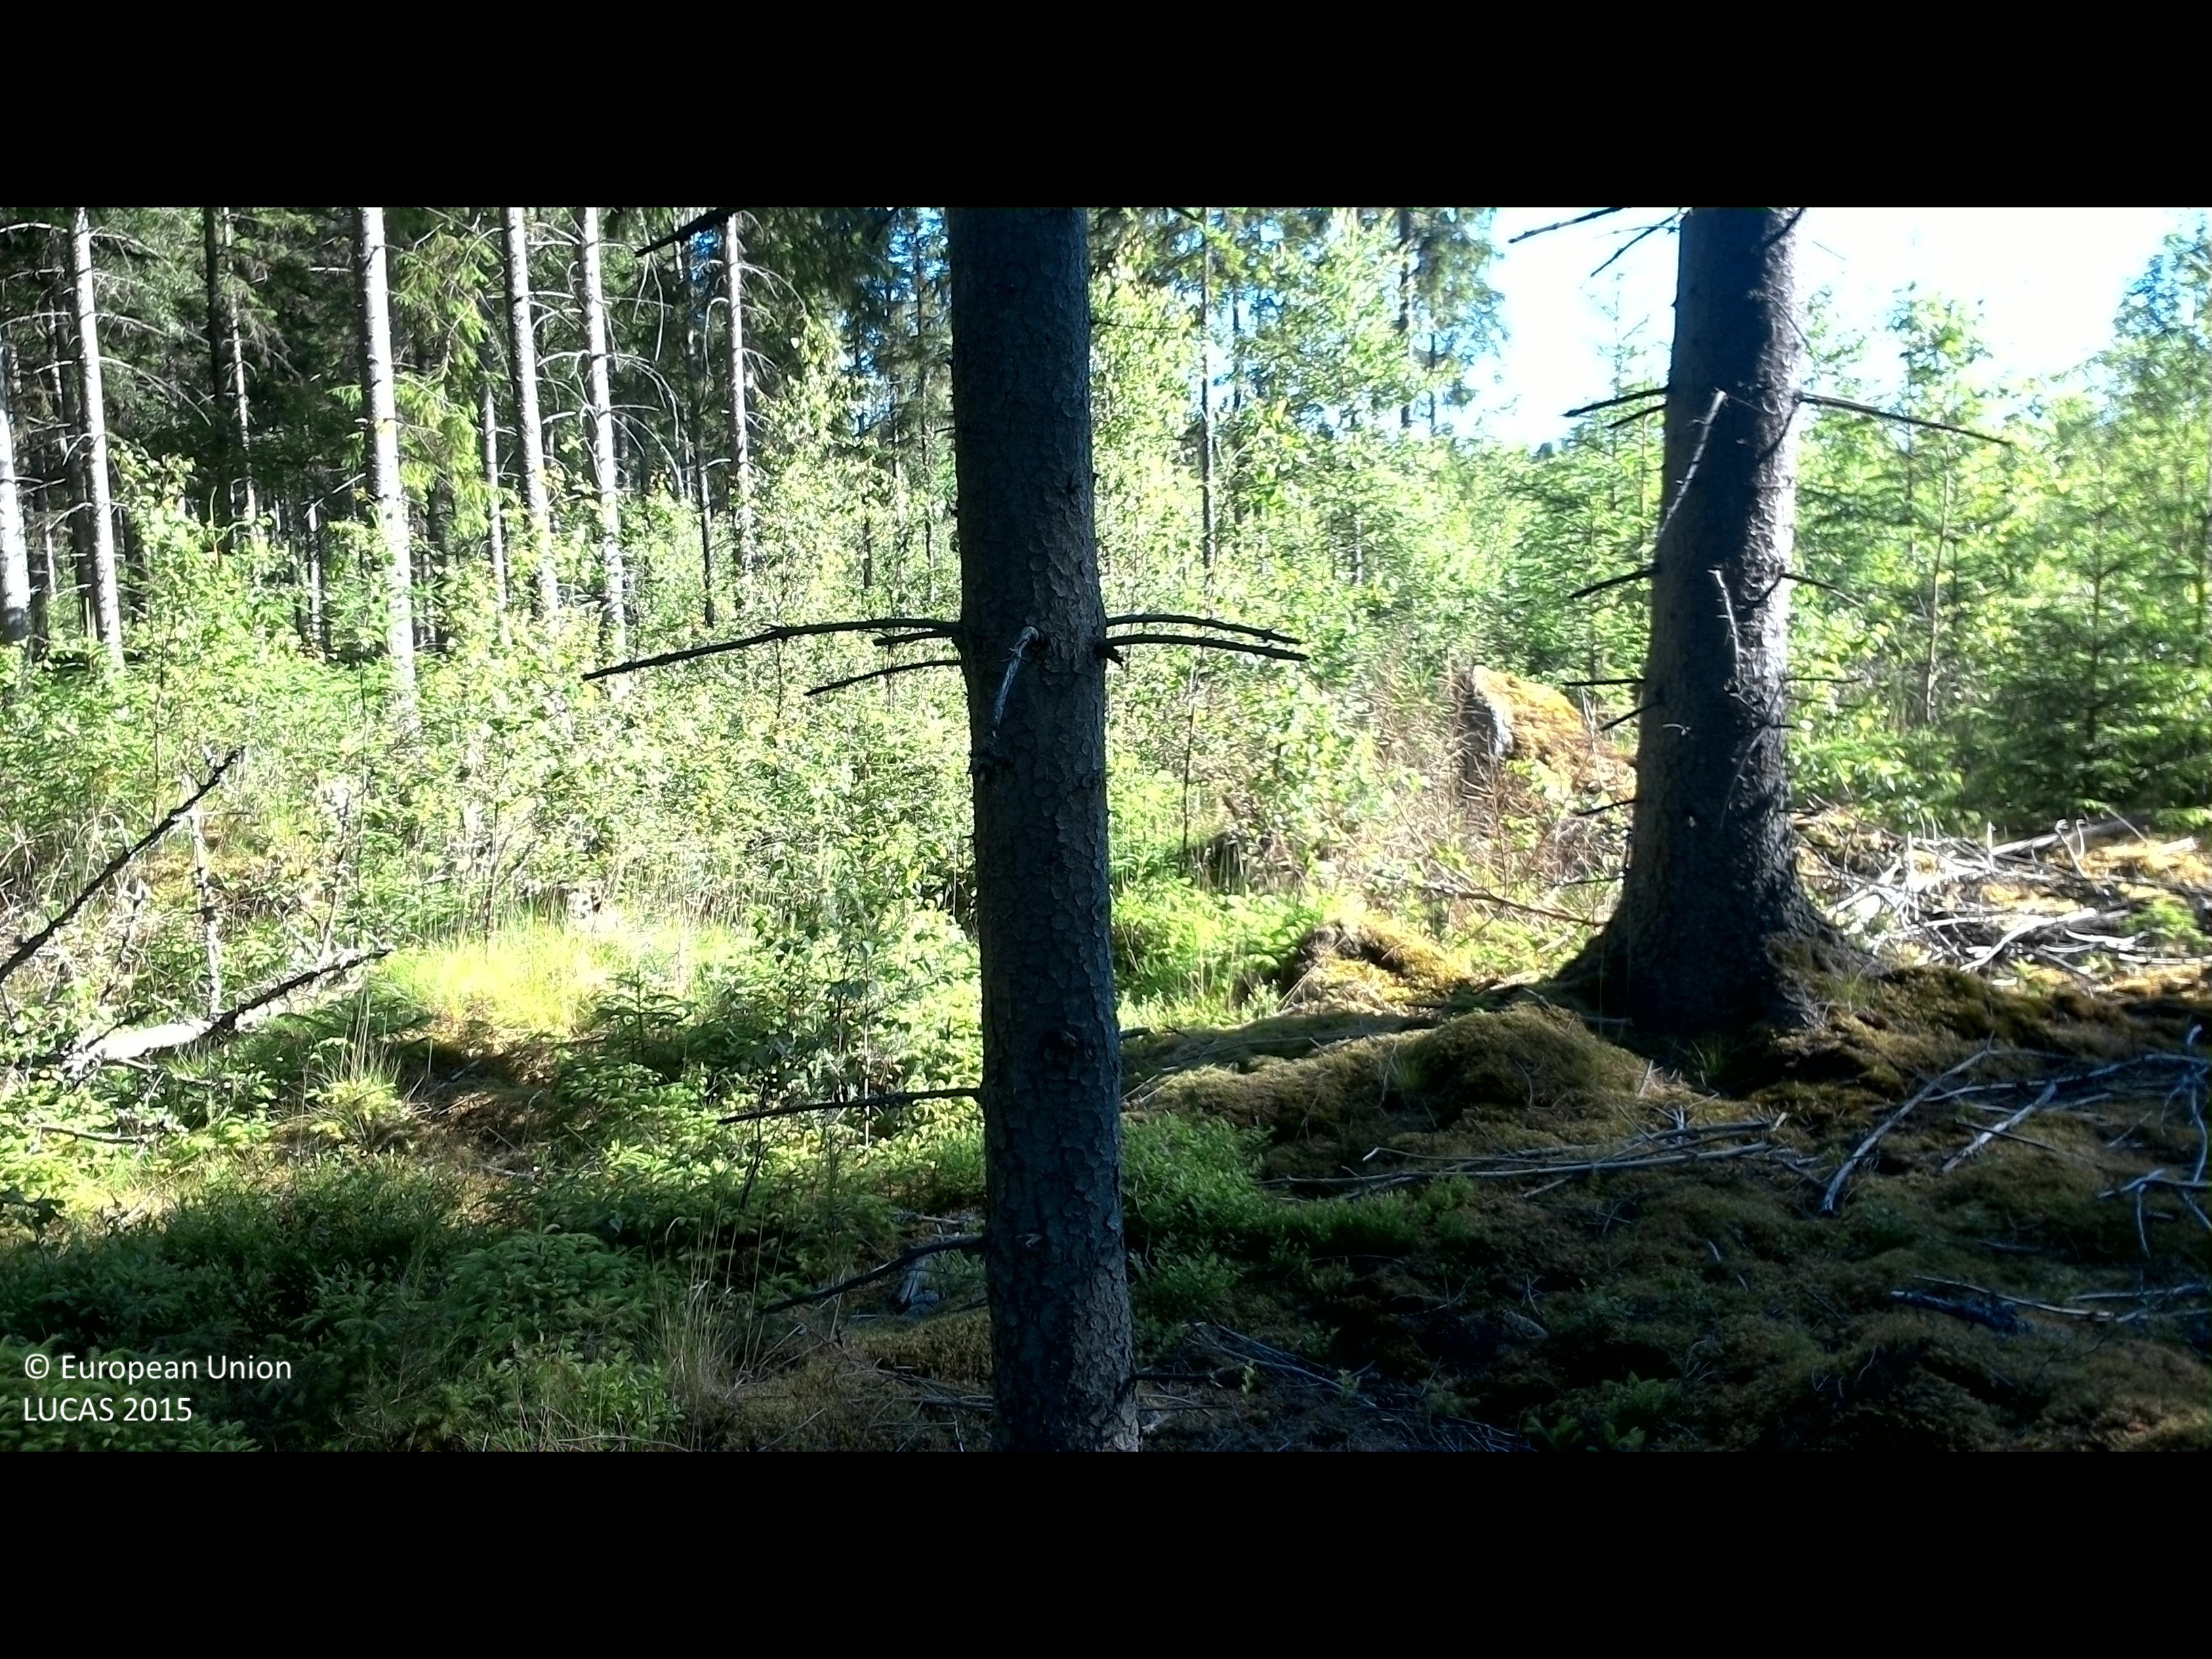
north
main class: Woodland
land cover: Spruce dominated coniferous woodland
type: boreal forest
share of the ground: 50 - 75 %
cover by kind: coniferous forest trees 60 %, shrubs 25 %, lichens and mosses 10 %, broadleaved forest trees 5 %
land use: Forestry
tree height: > 5 m
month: July
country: SE
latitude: 56.5318
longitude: 14.7616
